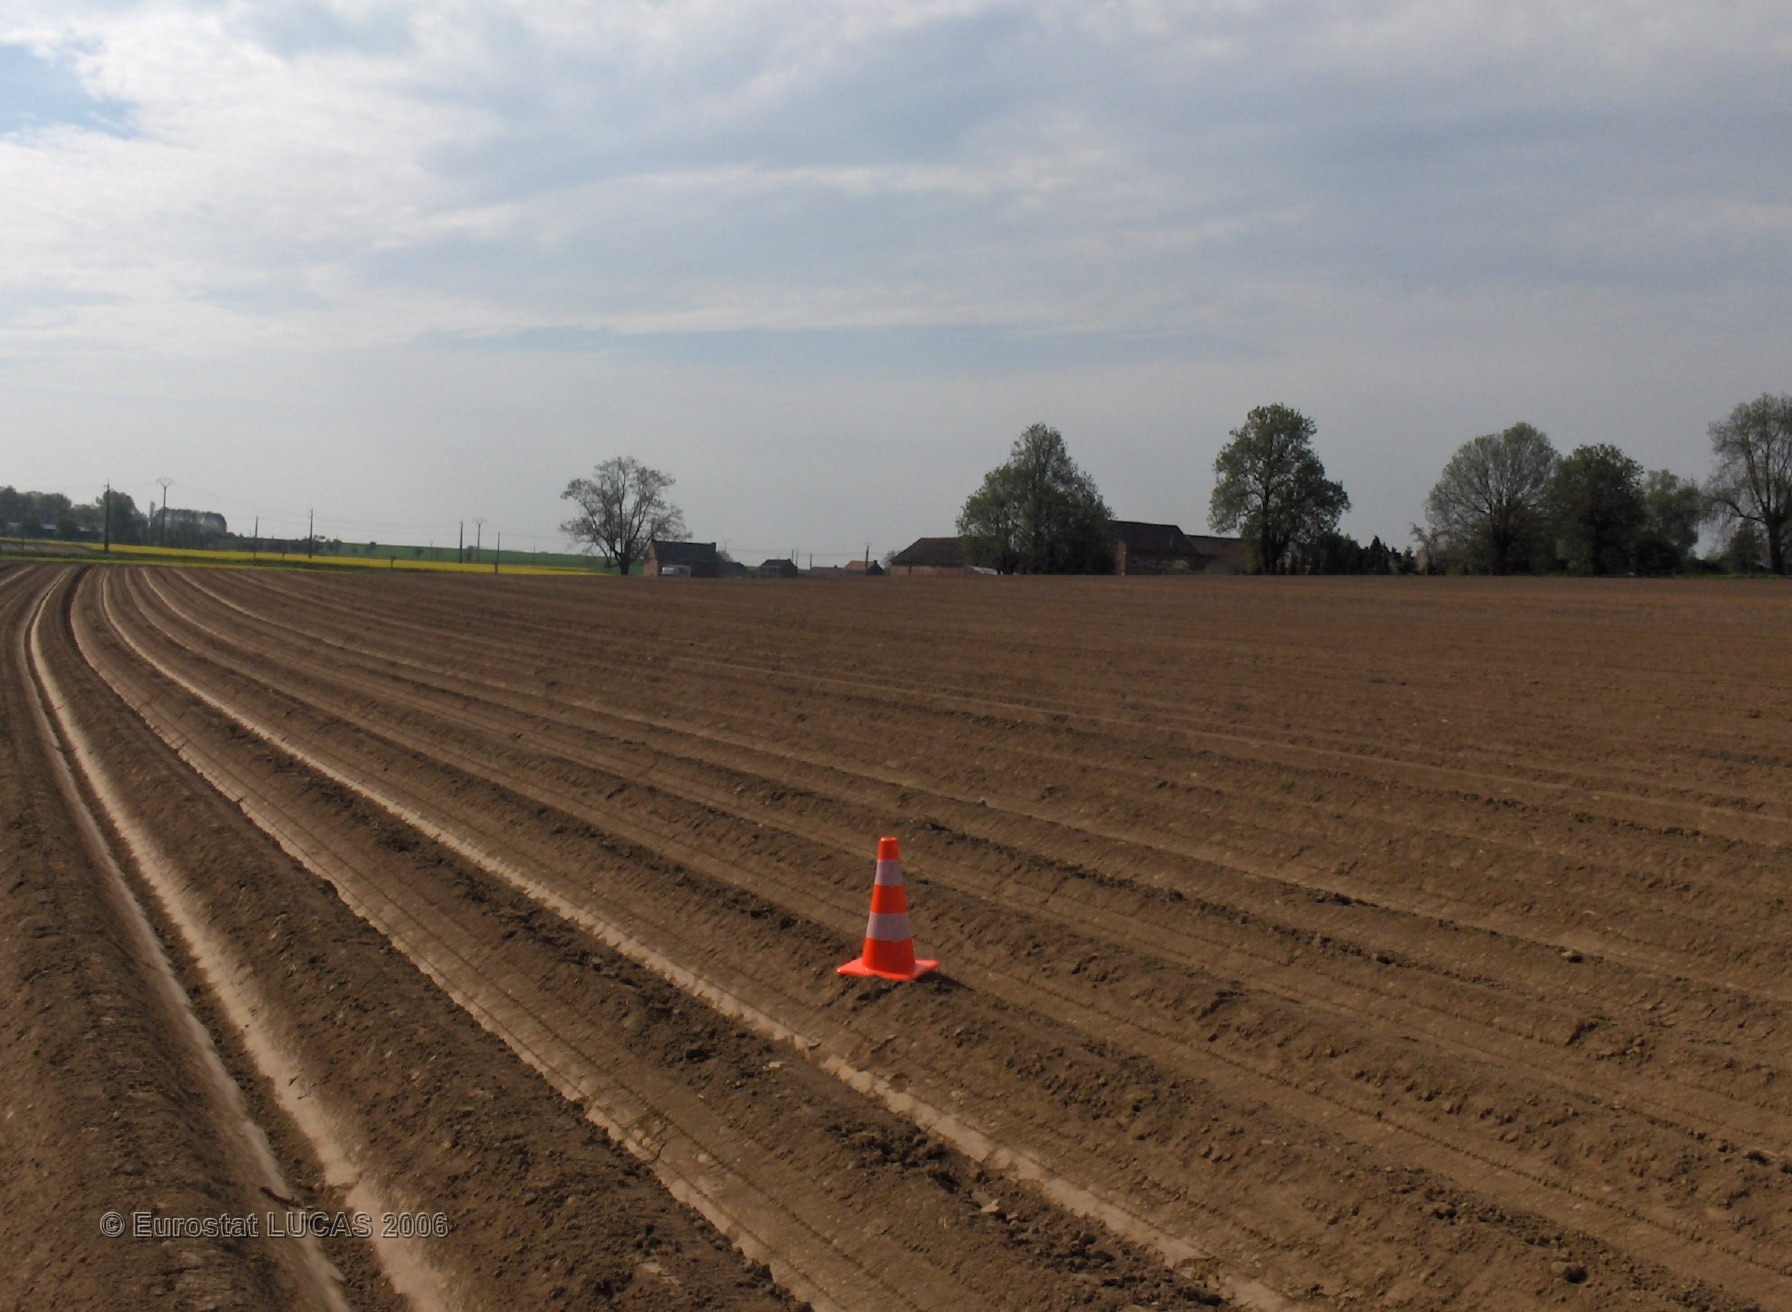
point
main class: Cropland
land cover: Potatoes
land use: Agriculture (excluding fallow land and kitchen gardens)
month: May
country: BE
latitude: 50.6609
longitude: 5.2302
